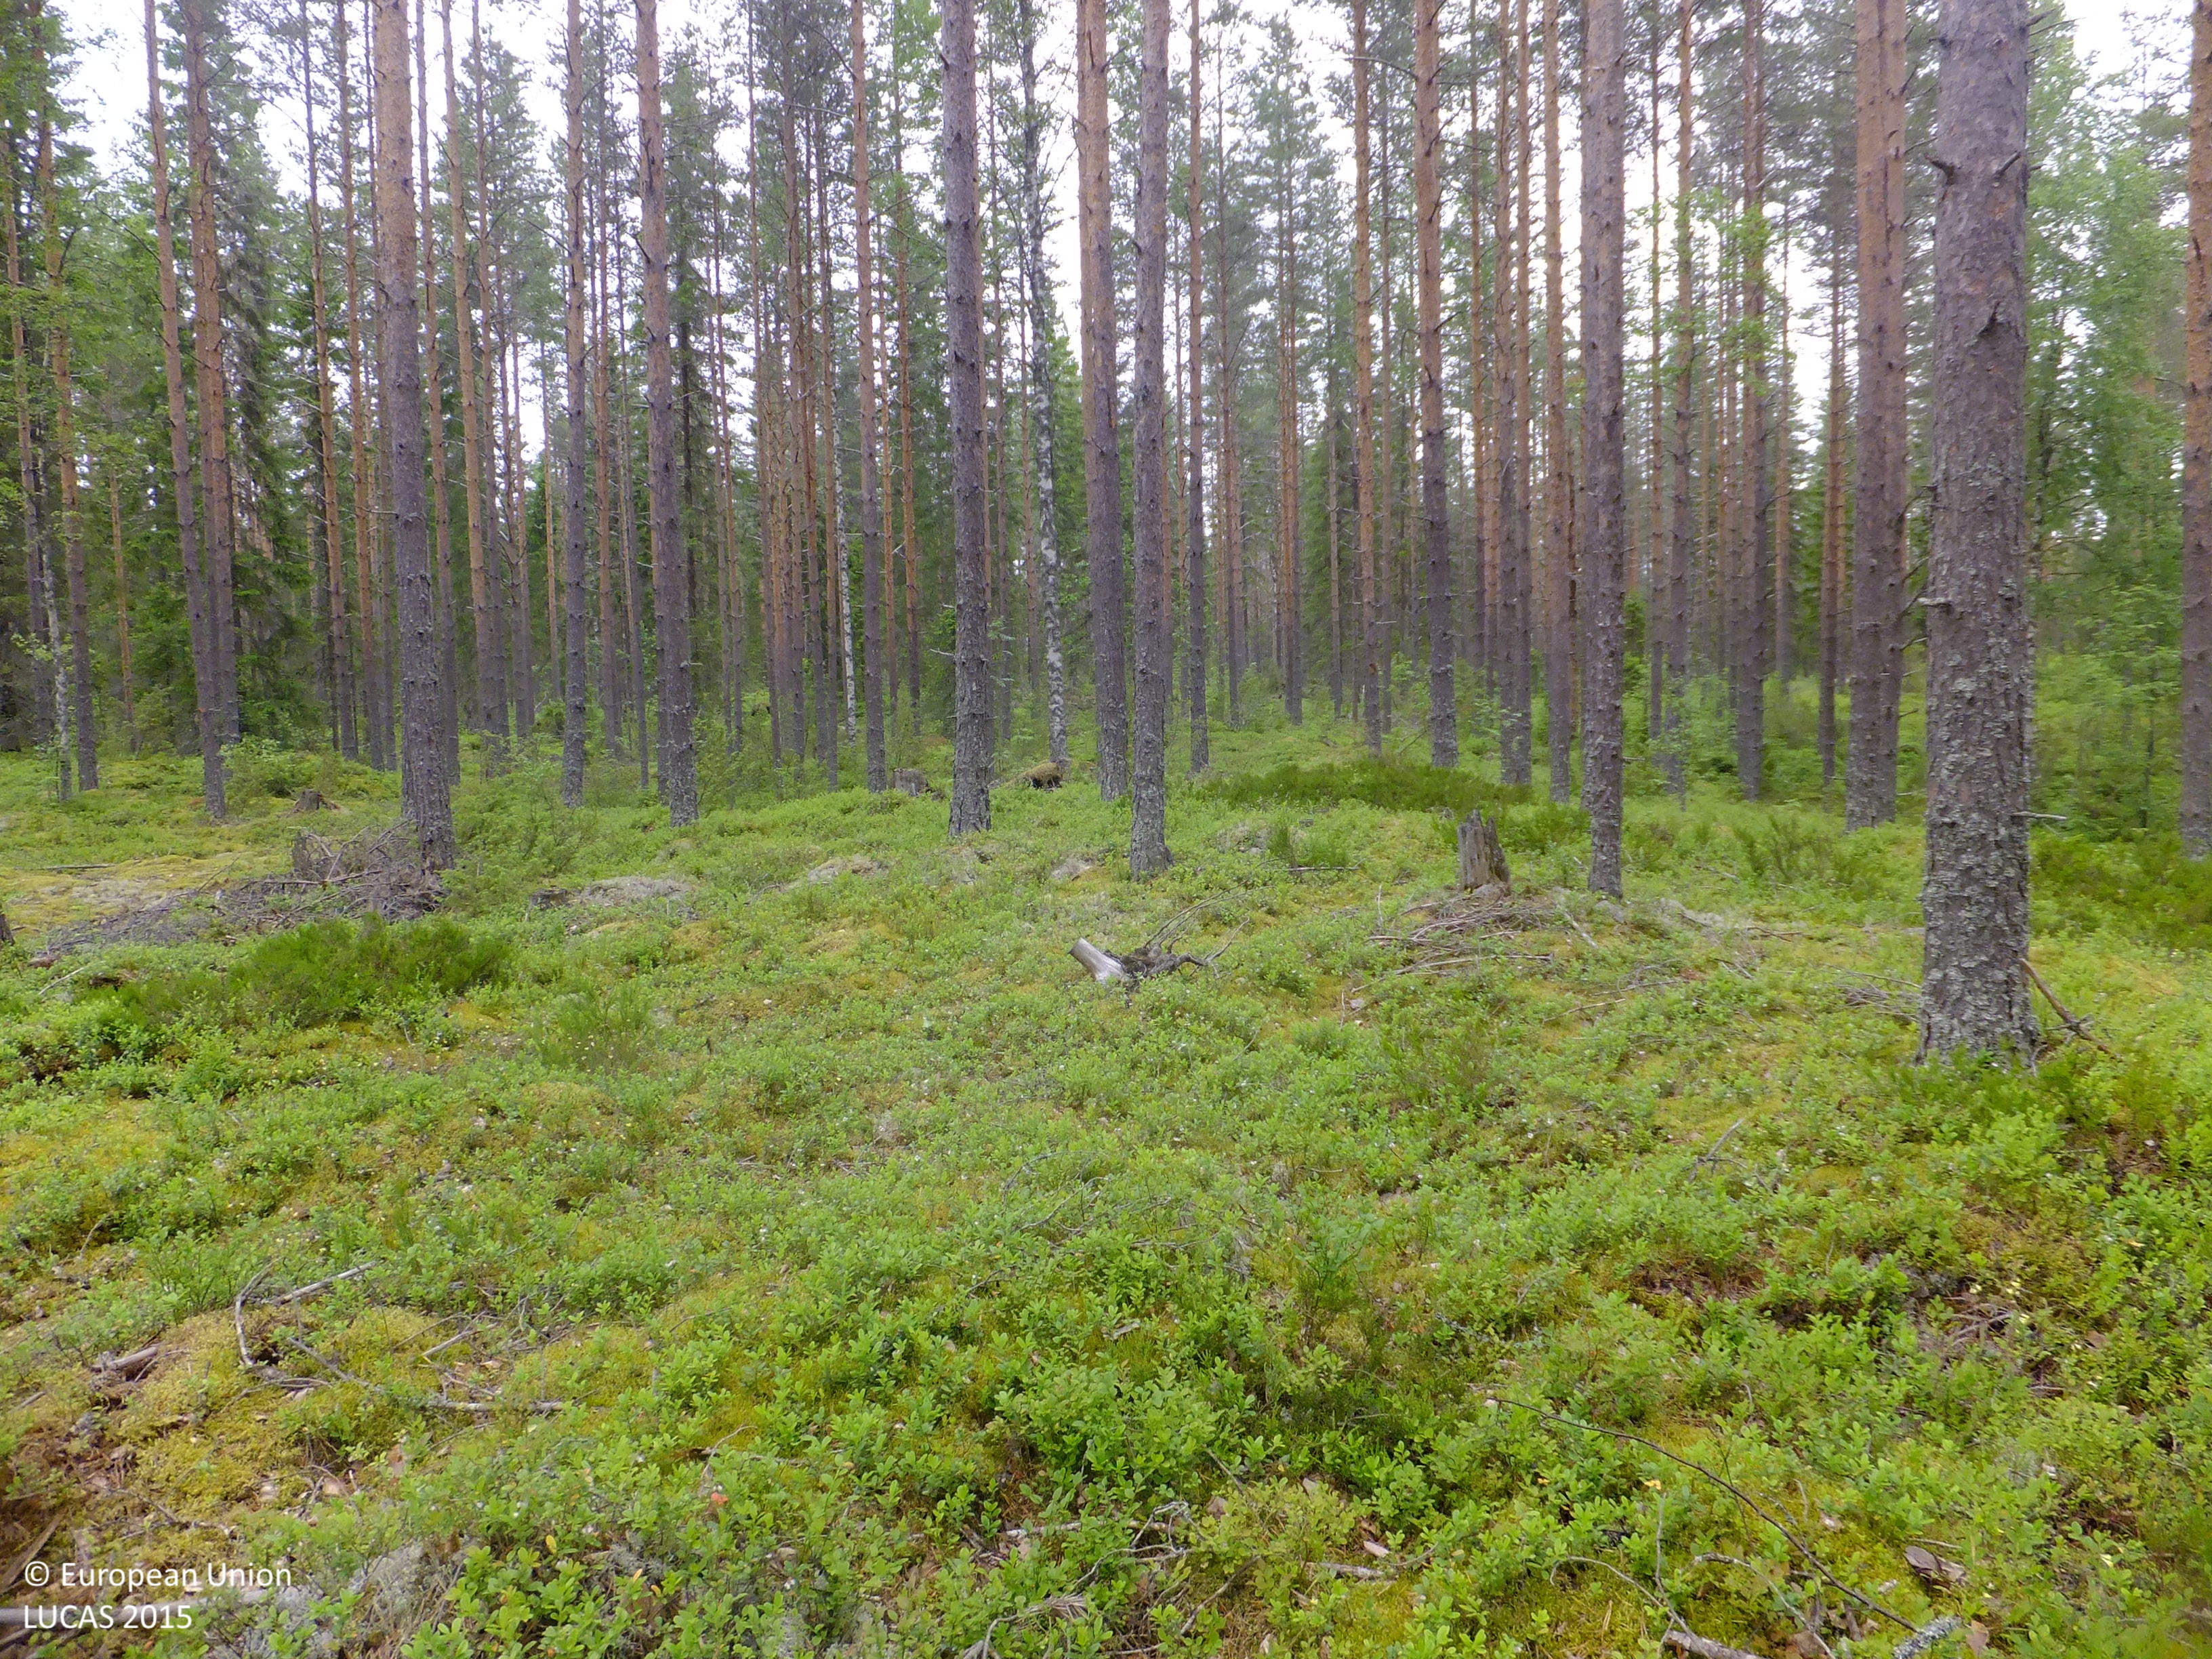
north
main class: Woodland
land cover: Pine dominated coniferous woodland
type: boreal forest
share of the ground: 50 - 75 %
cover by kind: coniferous forest trees 60 %, shrubs 20 %, lichens and mosses 15 %, broadleaved forest trees 5 %
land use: Forestry
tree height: > 5 m
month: July
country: FI
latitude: 63.1289
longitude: 24.7843
